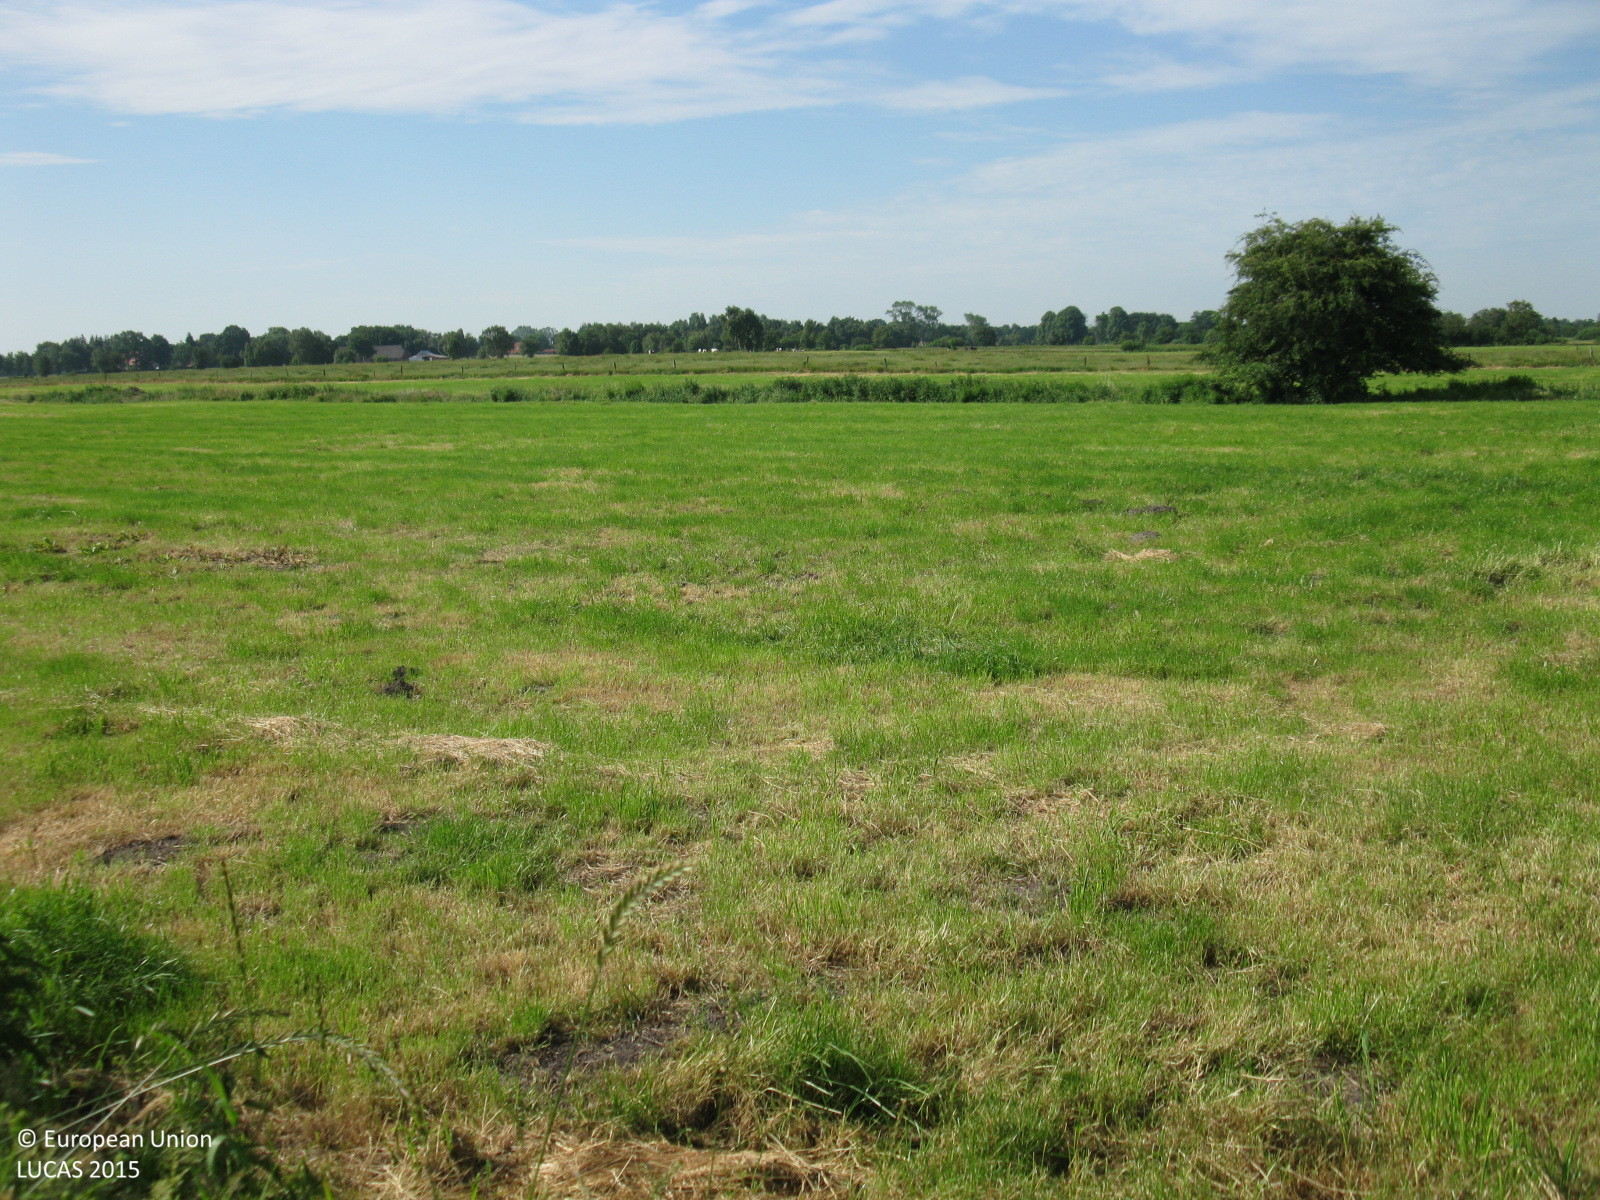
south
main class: Grassland
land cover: Grassland without tree/shrub cover
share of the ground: > 75 %
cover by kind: herbaceous plants 100 %
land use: Agriculture (excluding fallow land and kitchen gardens)
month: July
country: DE
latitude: 53.4639
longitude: 7.3948
